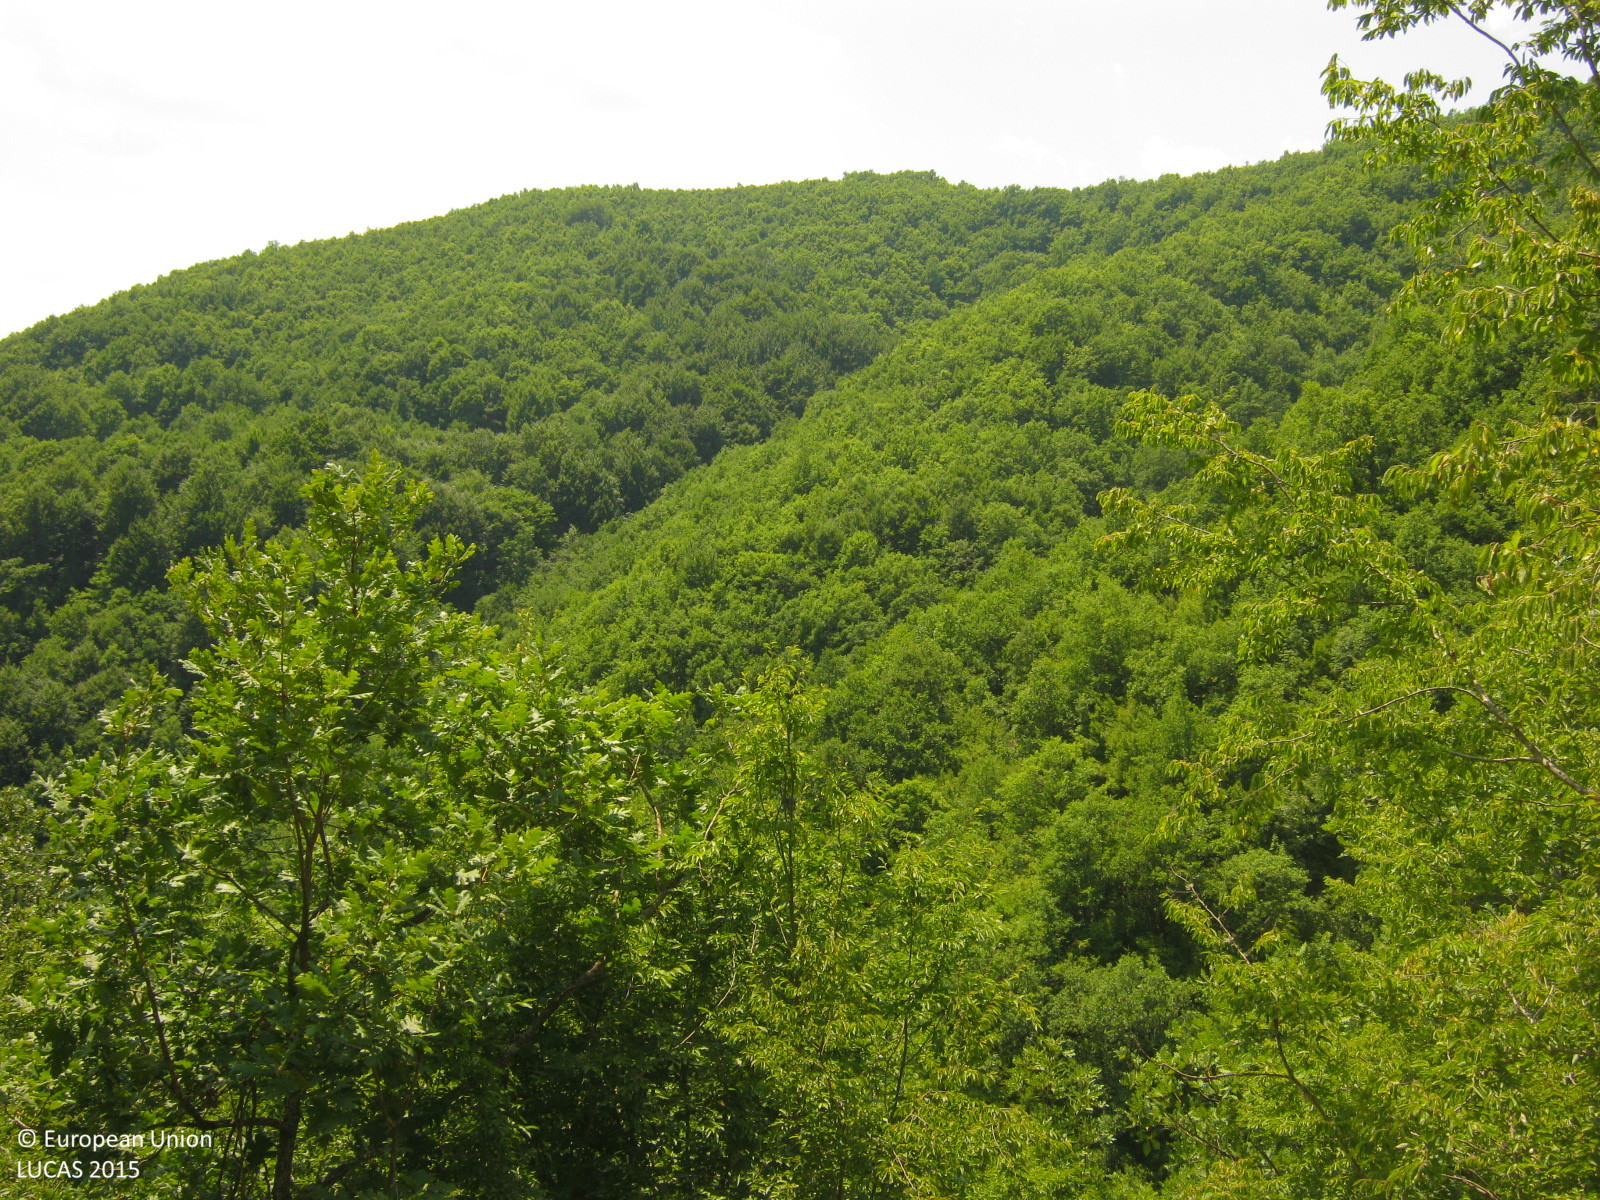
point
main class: Woodland
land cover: Broadleaved woodland
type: thermophilous deciduous forest
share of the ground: > 75 %
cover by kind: broadleaved forest trees 100 %
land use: Forestry
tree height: > 5 m
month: July
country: GR
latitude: 41.2688
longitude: 25.0267
